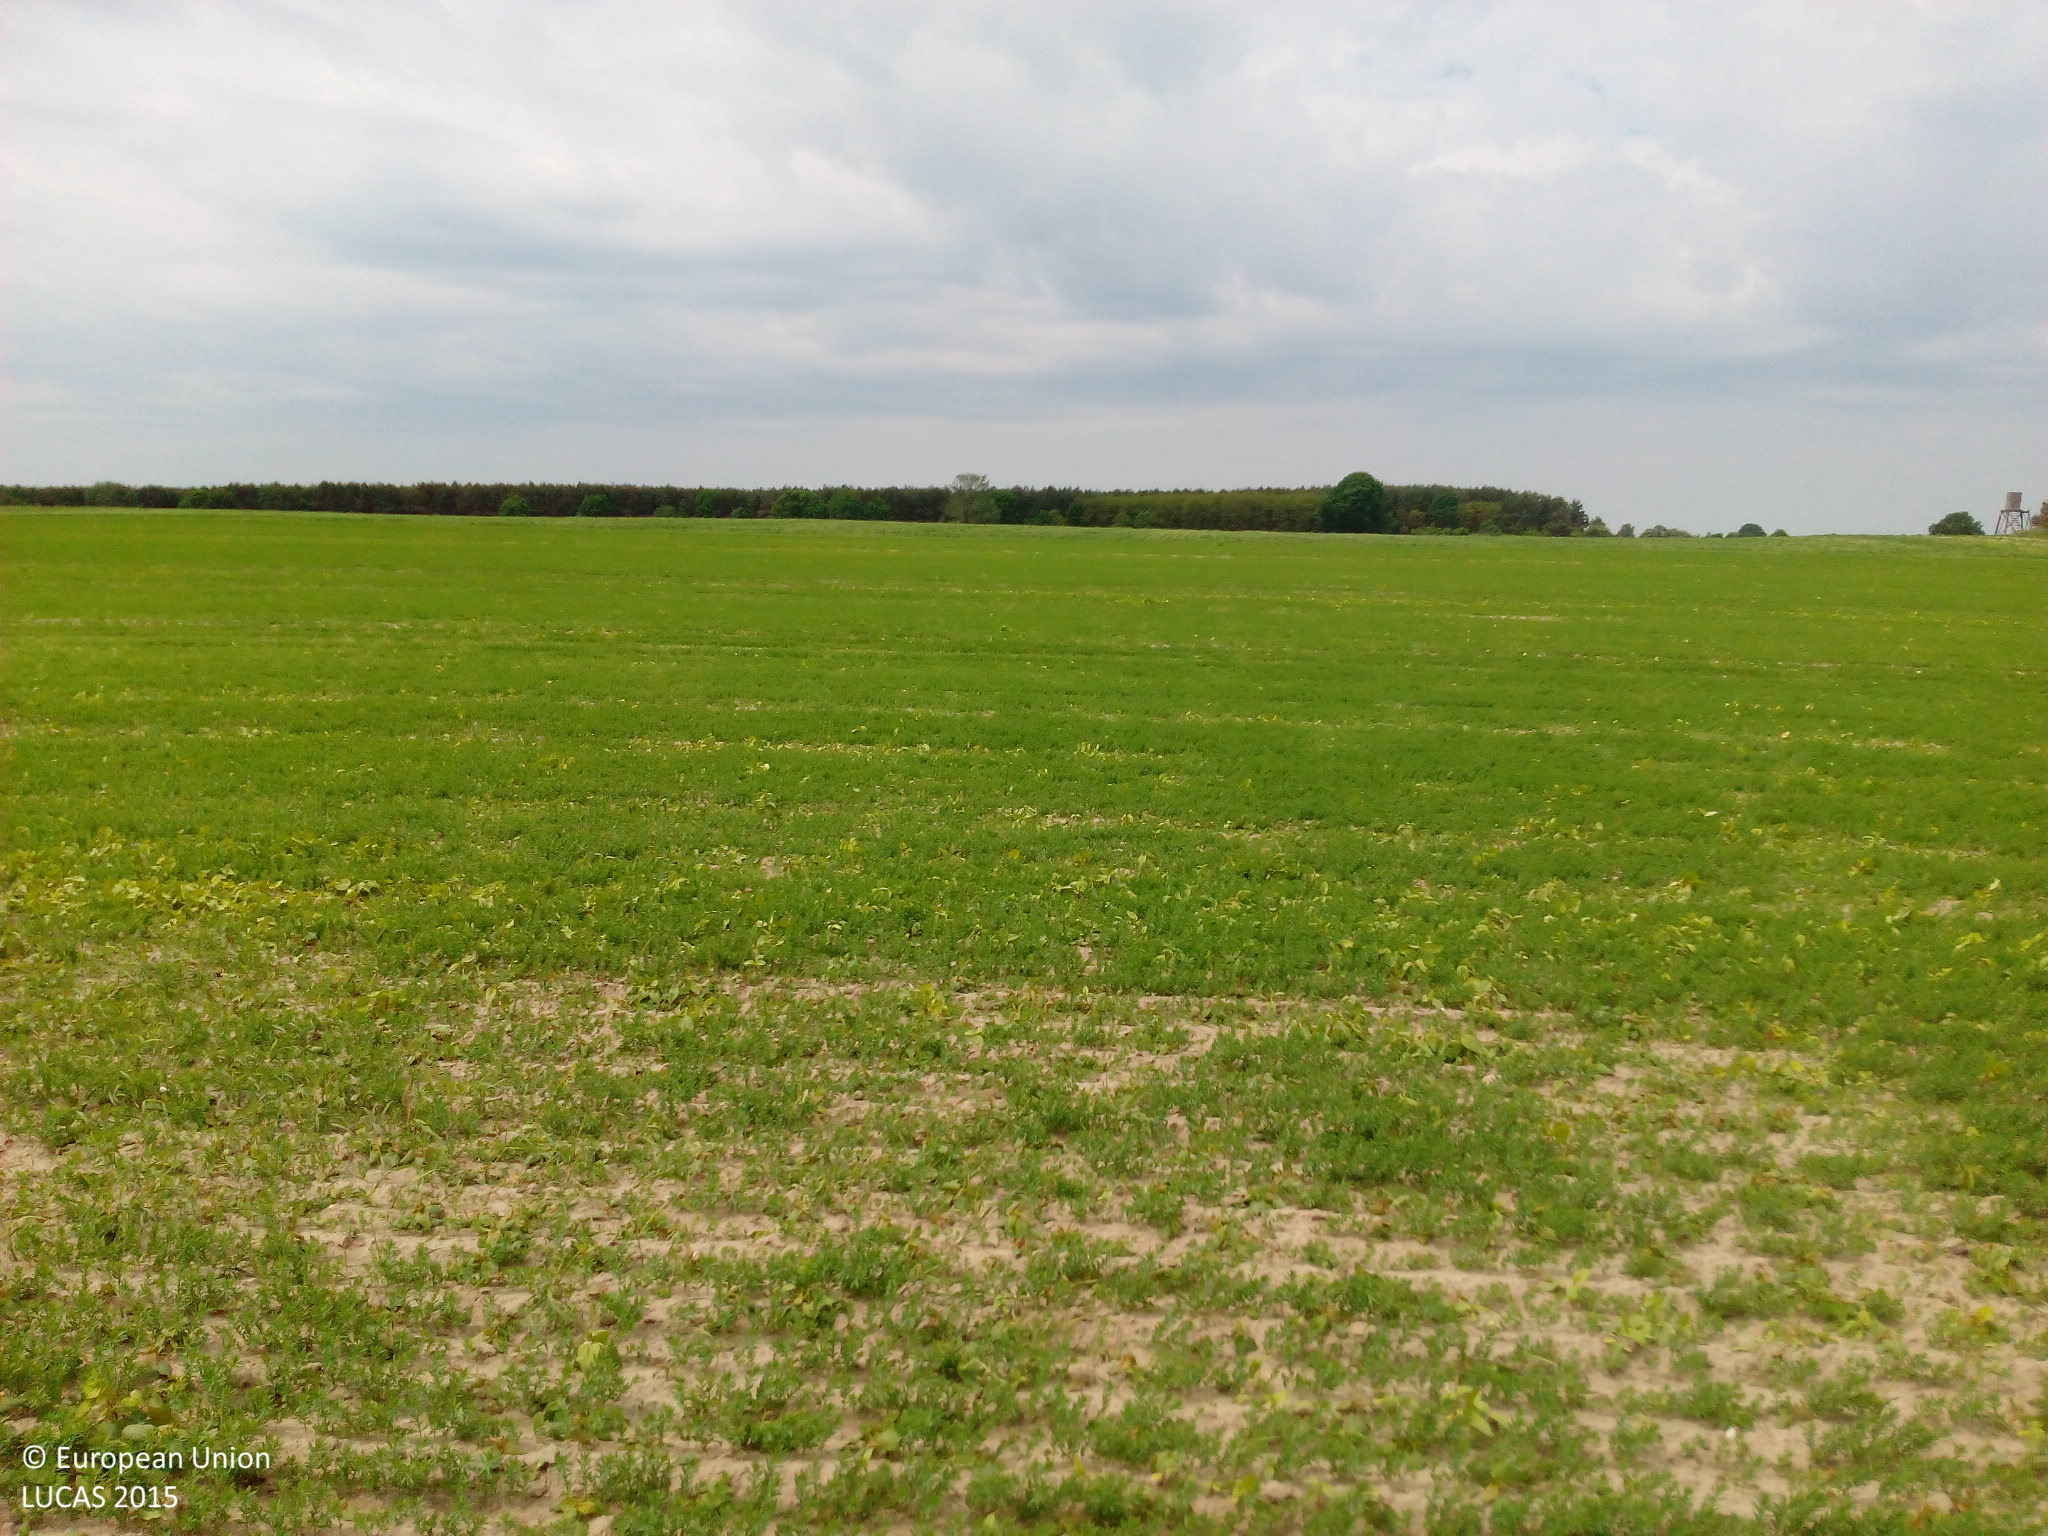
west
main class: Cropland
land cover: Lucerne
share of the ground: 10 - 25 %
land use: Agriculture (excluding fallow land and kitchen gardens)
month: May
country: DE
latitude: 52.0797
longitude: 12.5824
